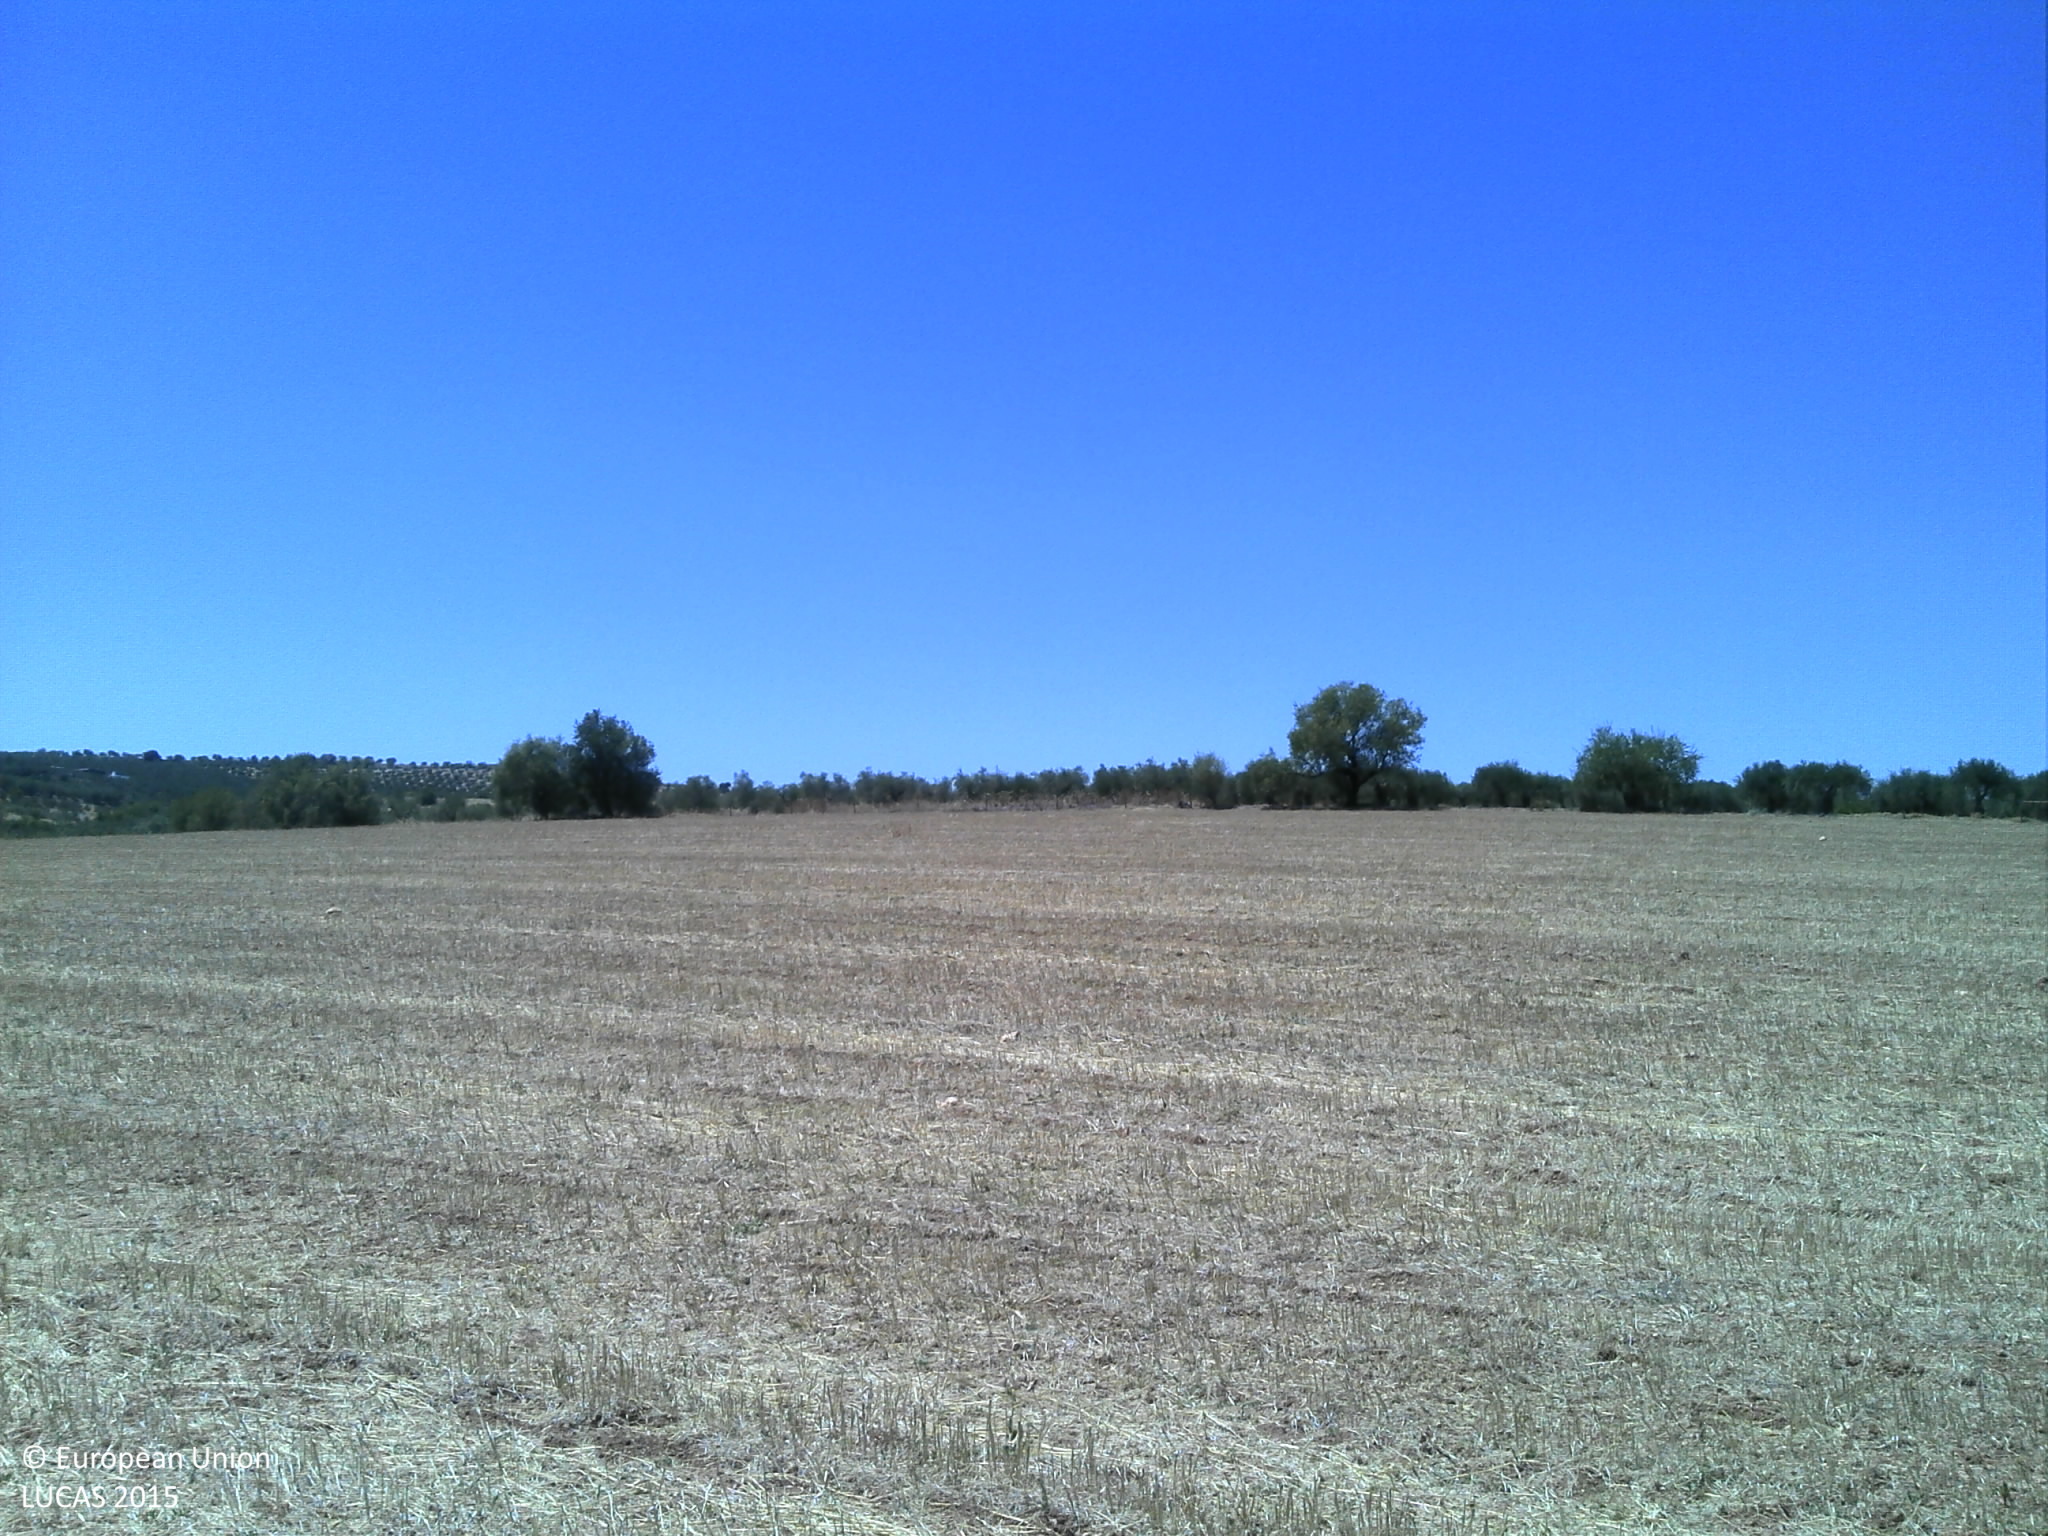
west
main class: Cropland
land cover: Oats
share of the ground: 10 - 25 %
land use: Agriculture (excluding fallow land and kitchen gardens)
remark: Harvested field
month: July
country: PT
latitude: 38.9965
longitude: -7.0819
